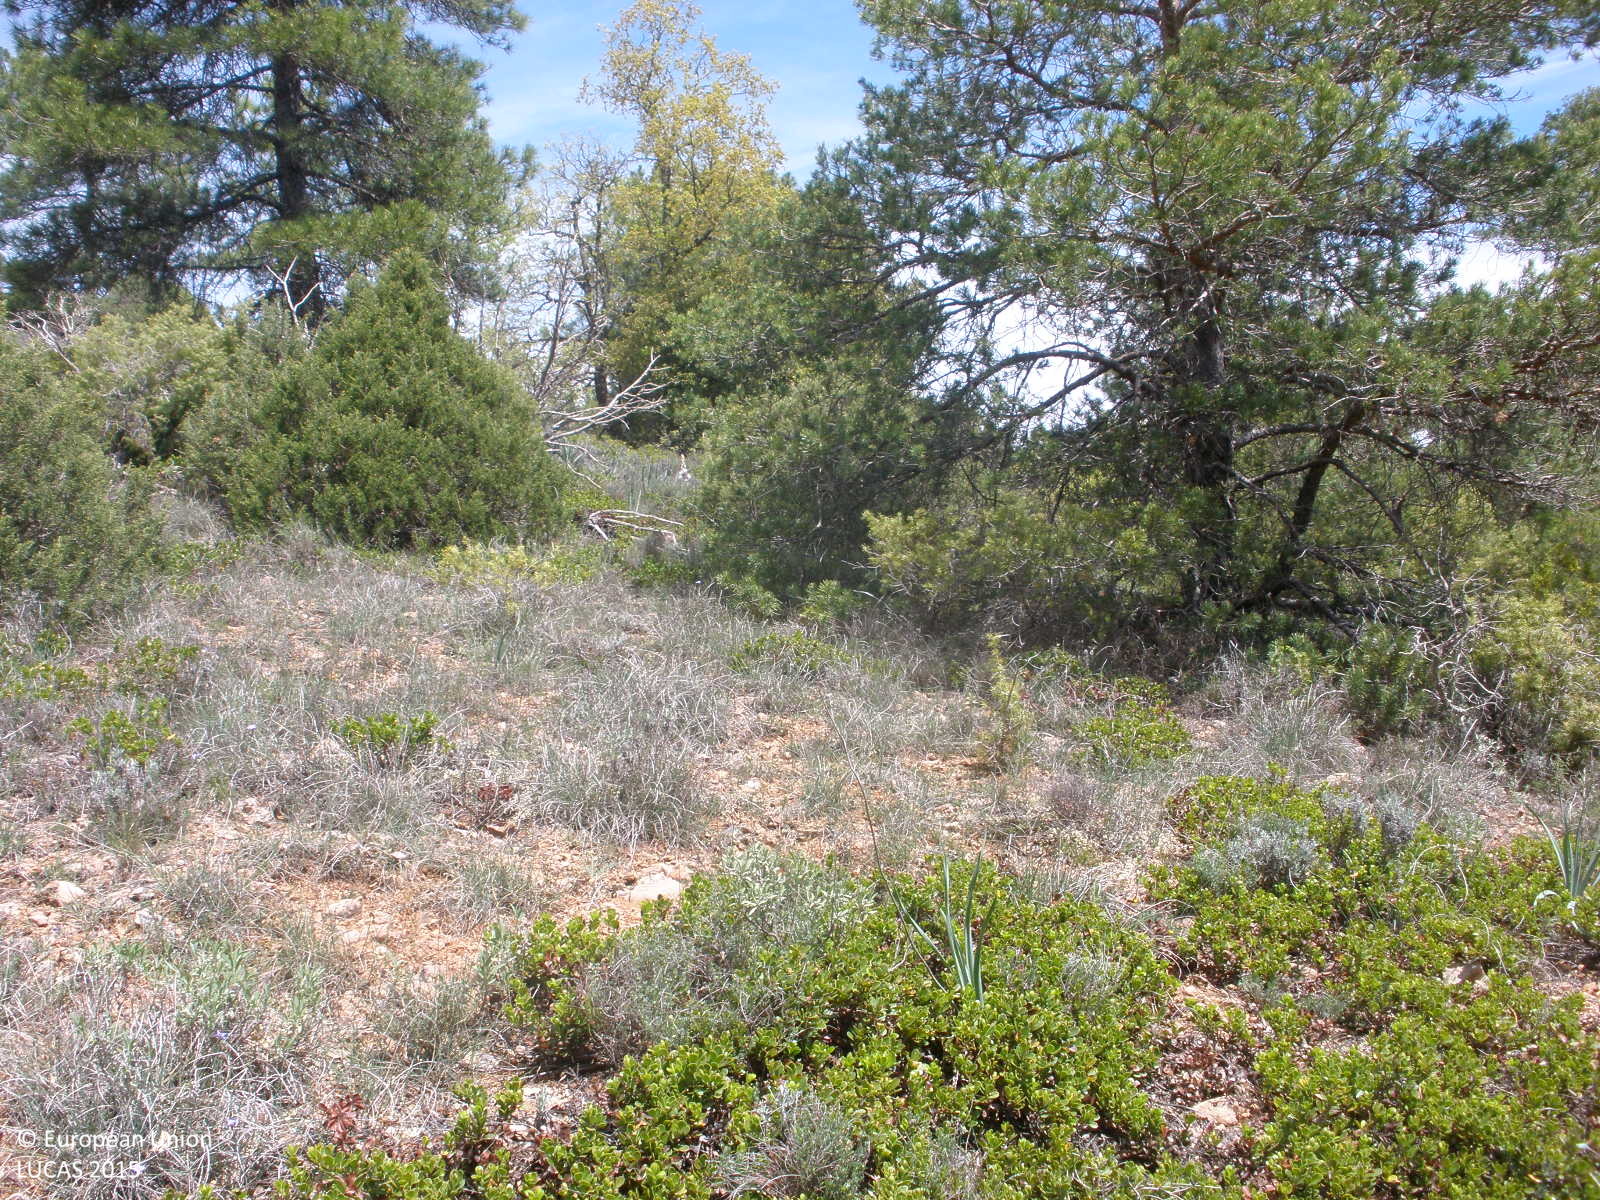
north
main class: Woodland
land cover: Pine dominated coniferous woodland
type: coniferous forest of the mediterranean region
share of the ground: 25 - 50 %
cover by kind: shrubs 60 %, coniferous forest trees 30 %, consolidated bare surface 10 %
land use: Semi-natural and natural areas not in use
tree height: > 5 m
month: May
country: ES
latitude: 40.9134
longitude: -0.9264
